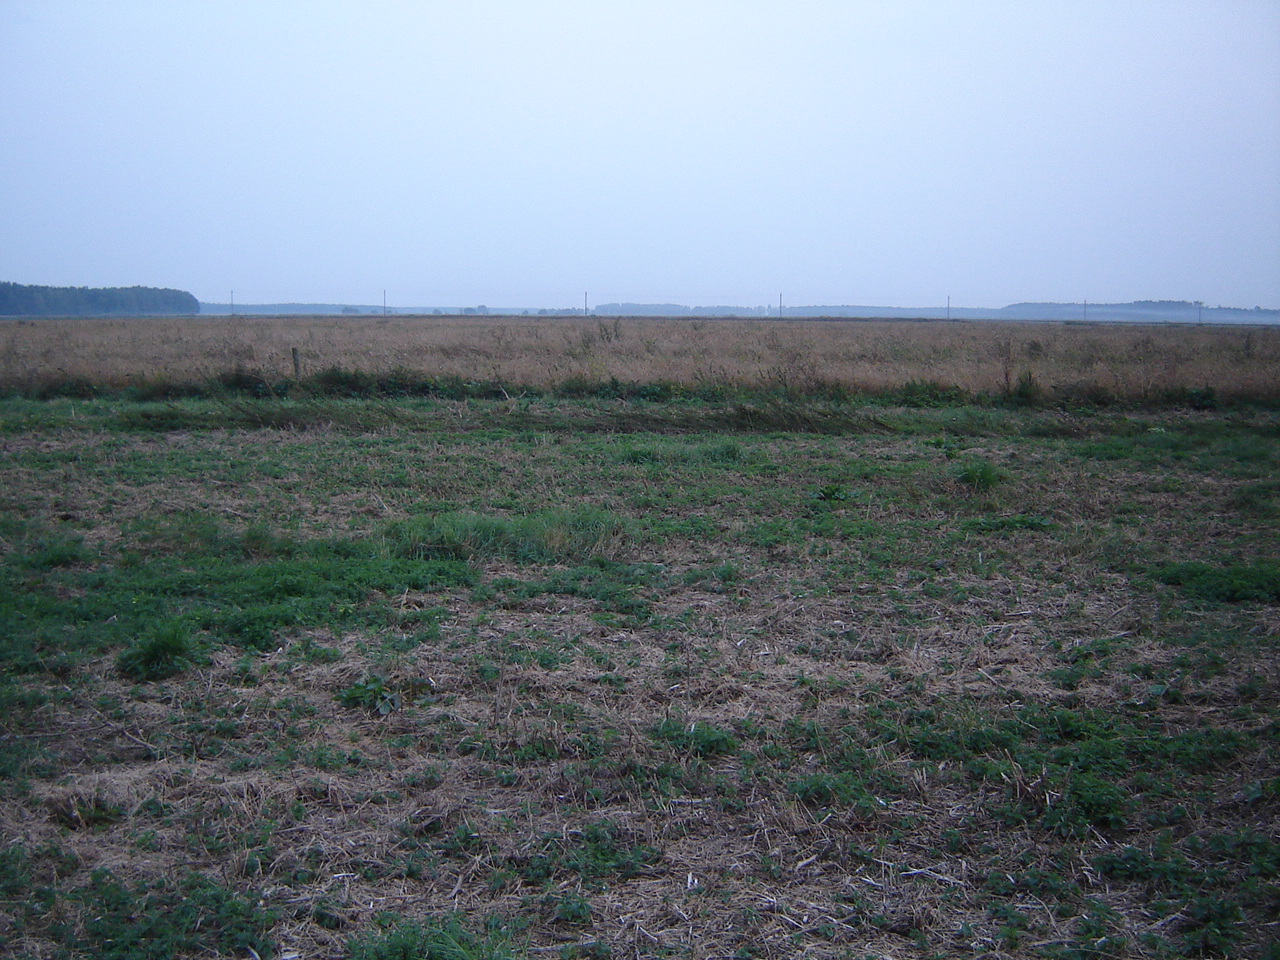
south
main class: Grassland
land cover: Grassland without tree/shrub cover
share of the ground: > 75 %
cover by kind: herbaceous plants 100 %
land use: Agriculture (excluding fallow land and kitchen gardens)
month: September
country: LT
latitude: 54.4218
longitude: 24.8293
